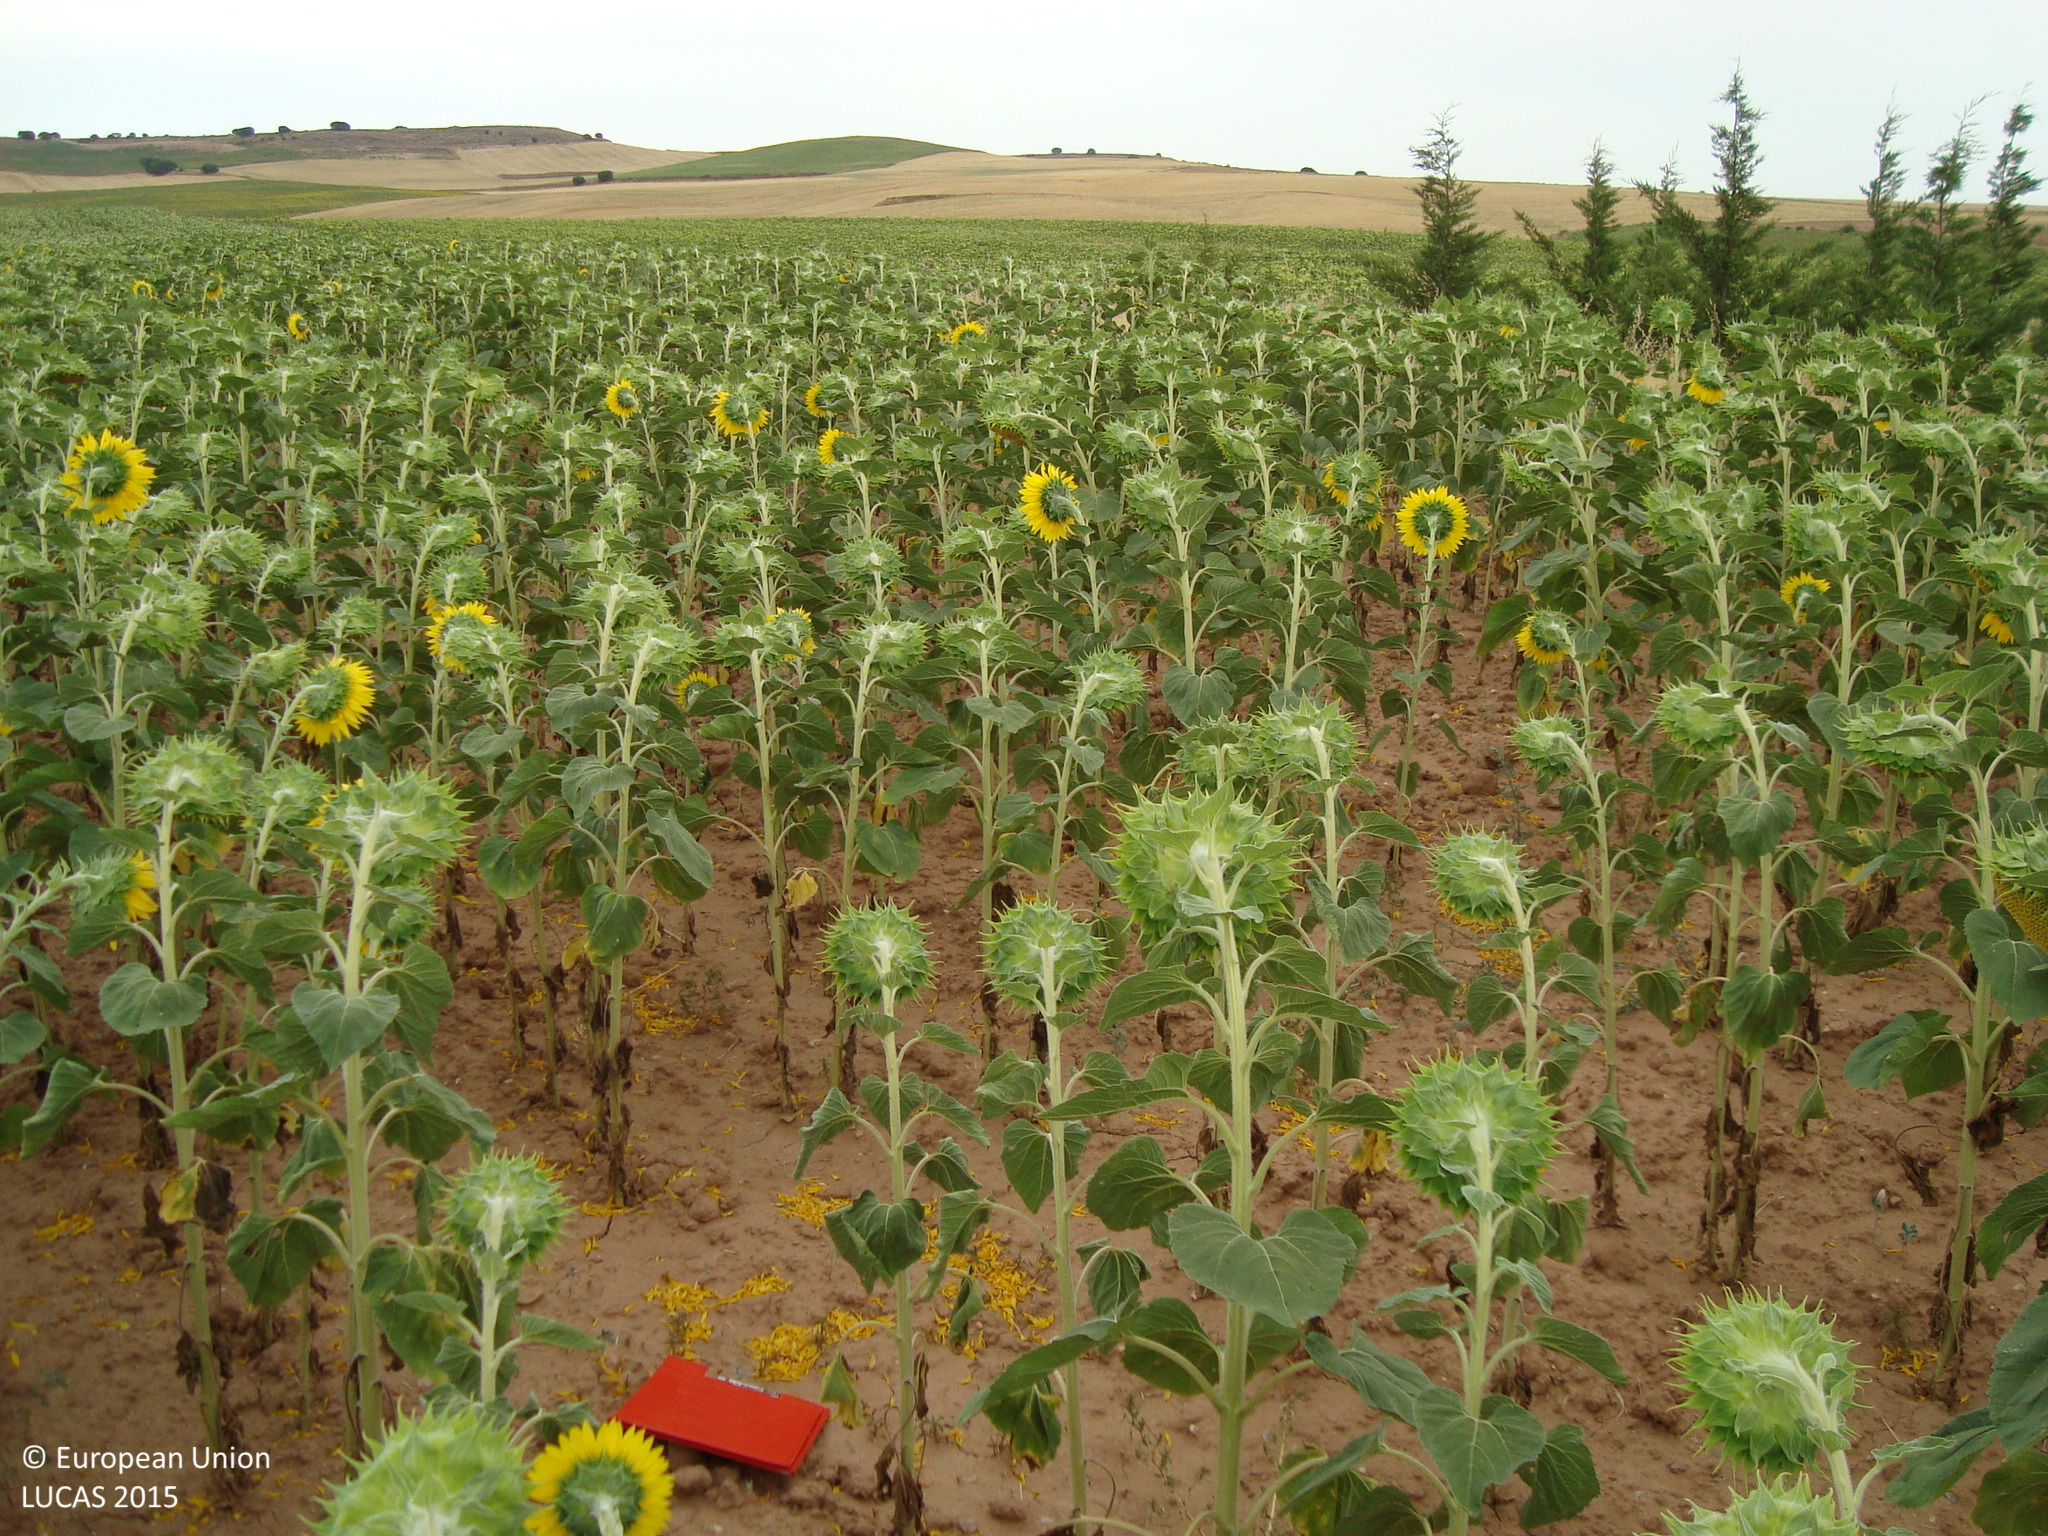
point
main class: Cropland
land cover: Sunflower
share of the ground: > 75 %
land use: Agriculture (excluding fallow land and kitchen gardens)
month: August
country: ES
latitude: 42.2053
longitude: -3.8814
